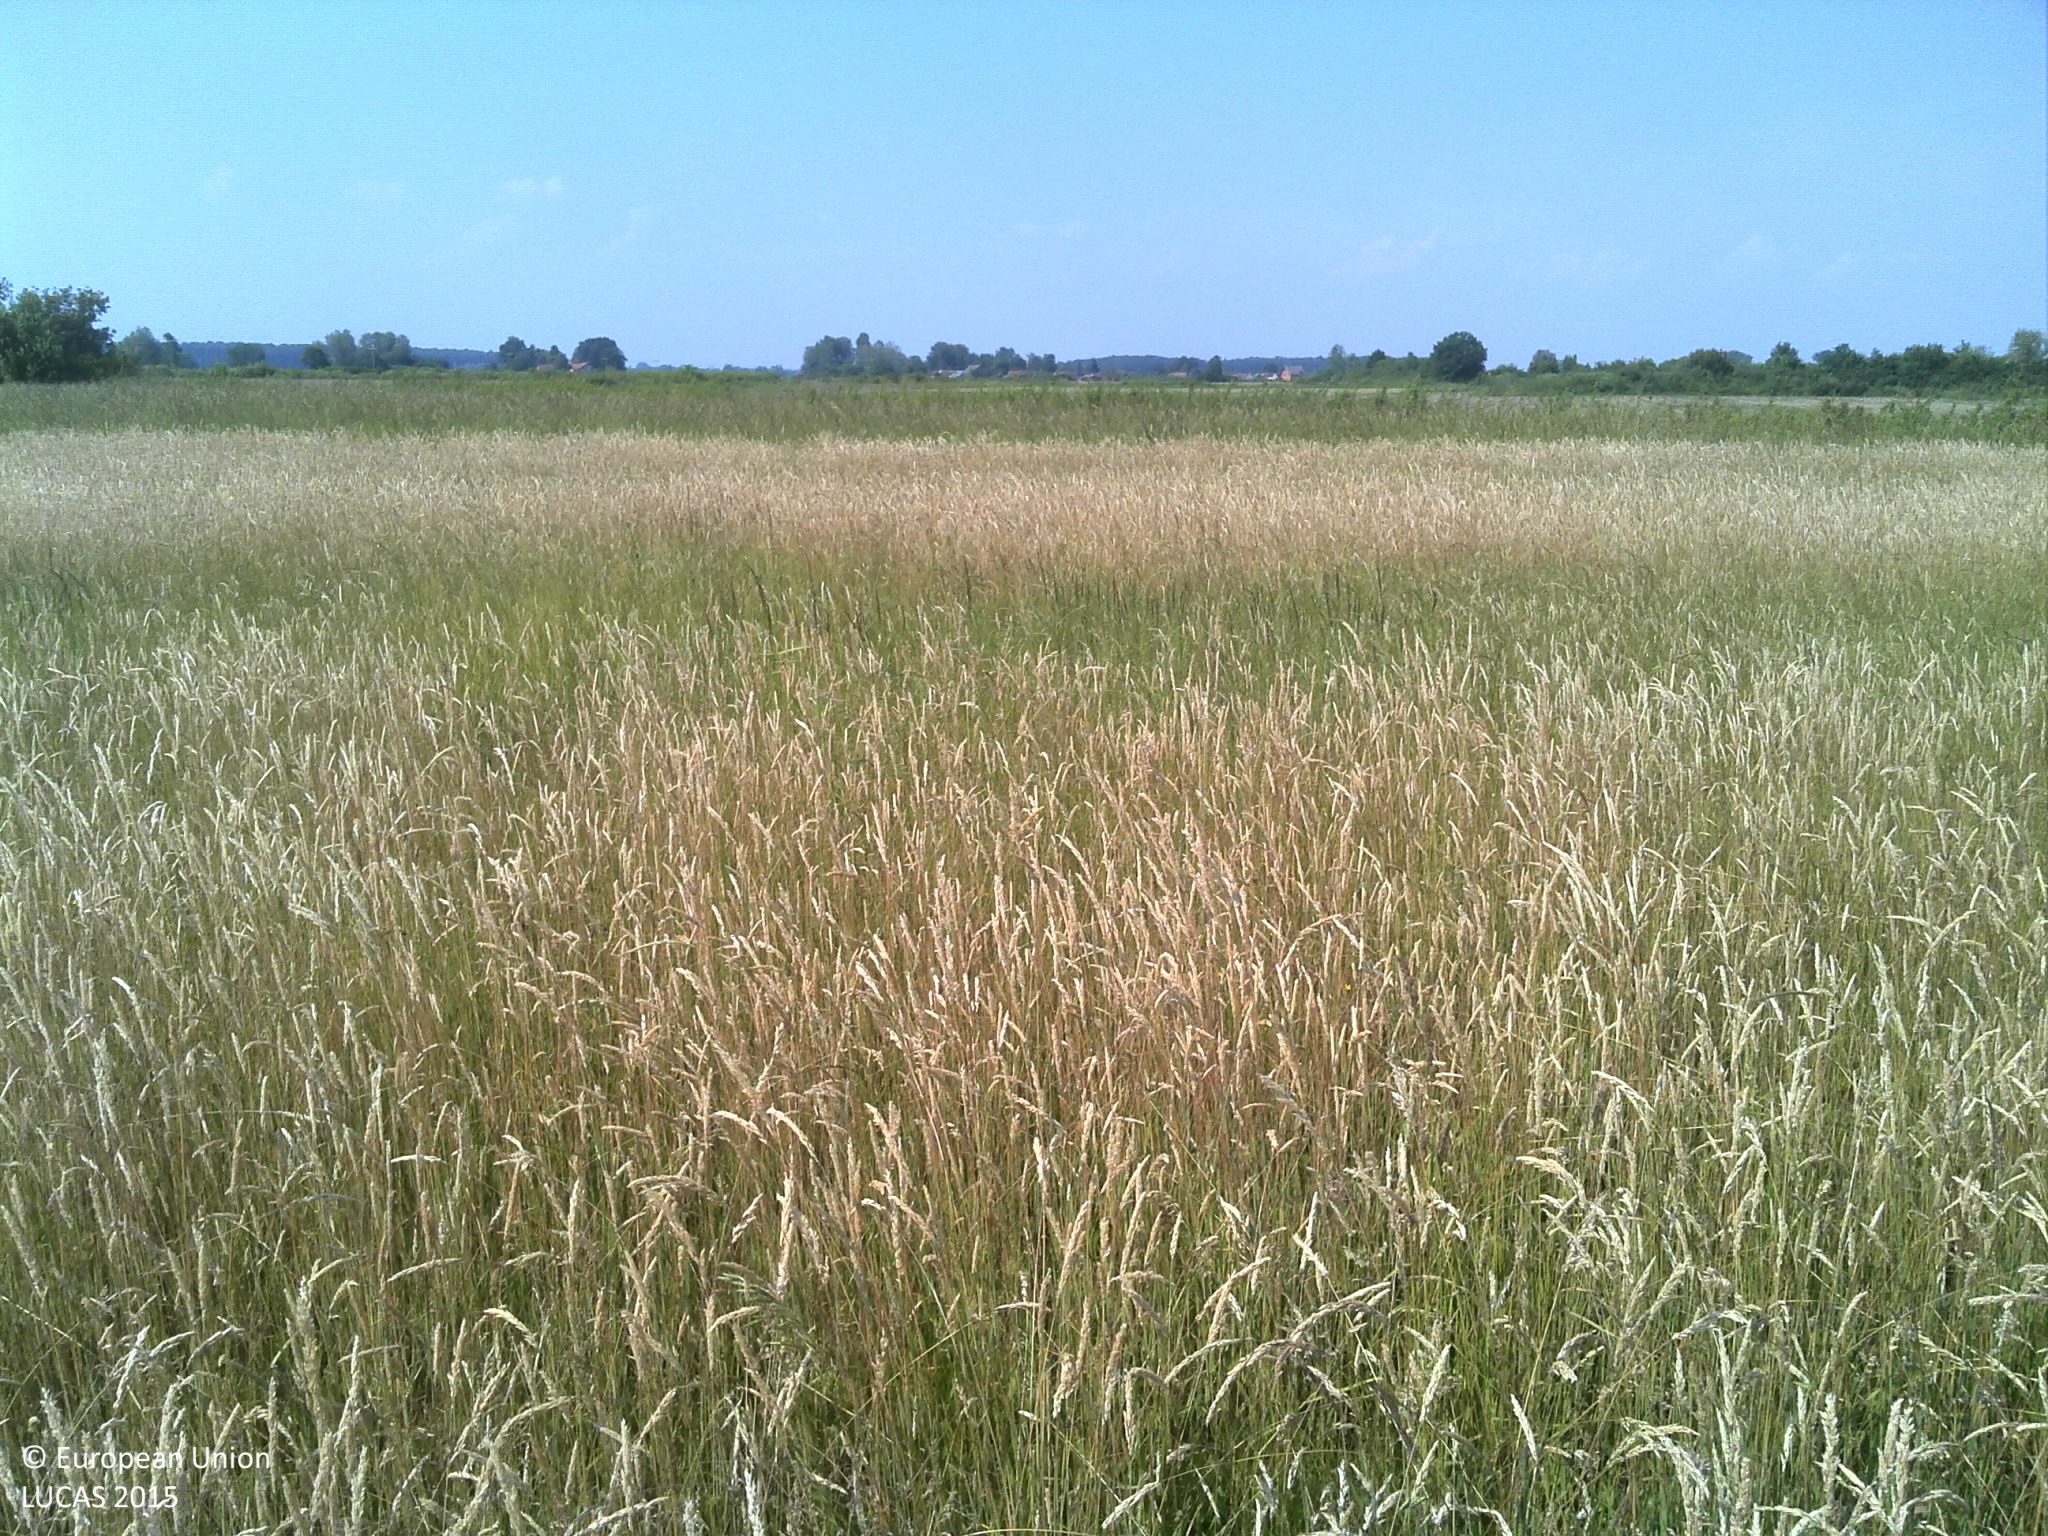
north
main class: Grassland
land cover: Spontaneously vegetated surfaces
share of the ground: > 75 %
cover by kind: herbaceous plants 100 %
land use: Fallow land
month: June
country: HR
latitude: 45.7004
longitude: 17.8511
